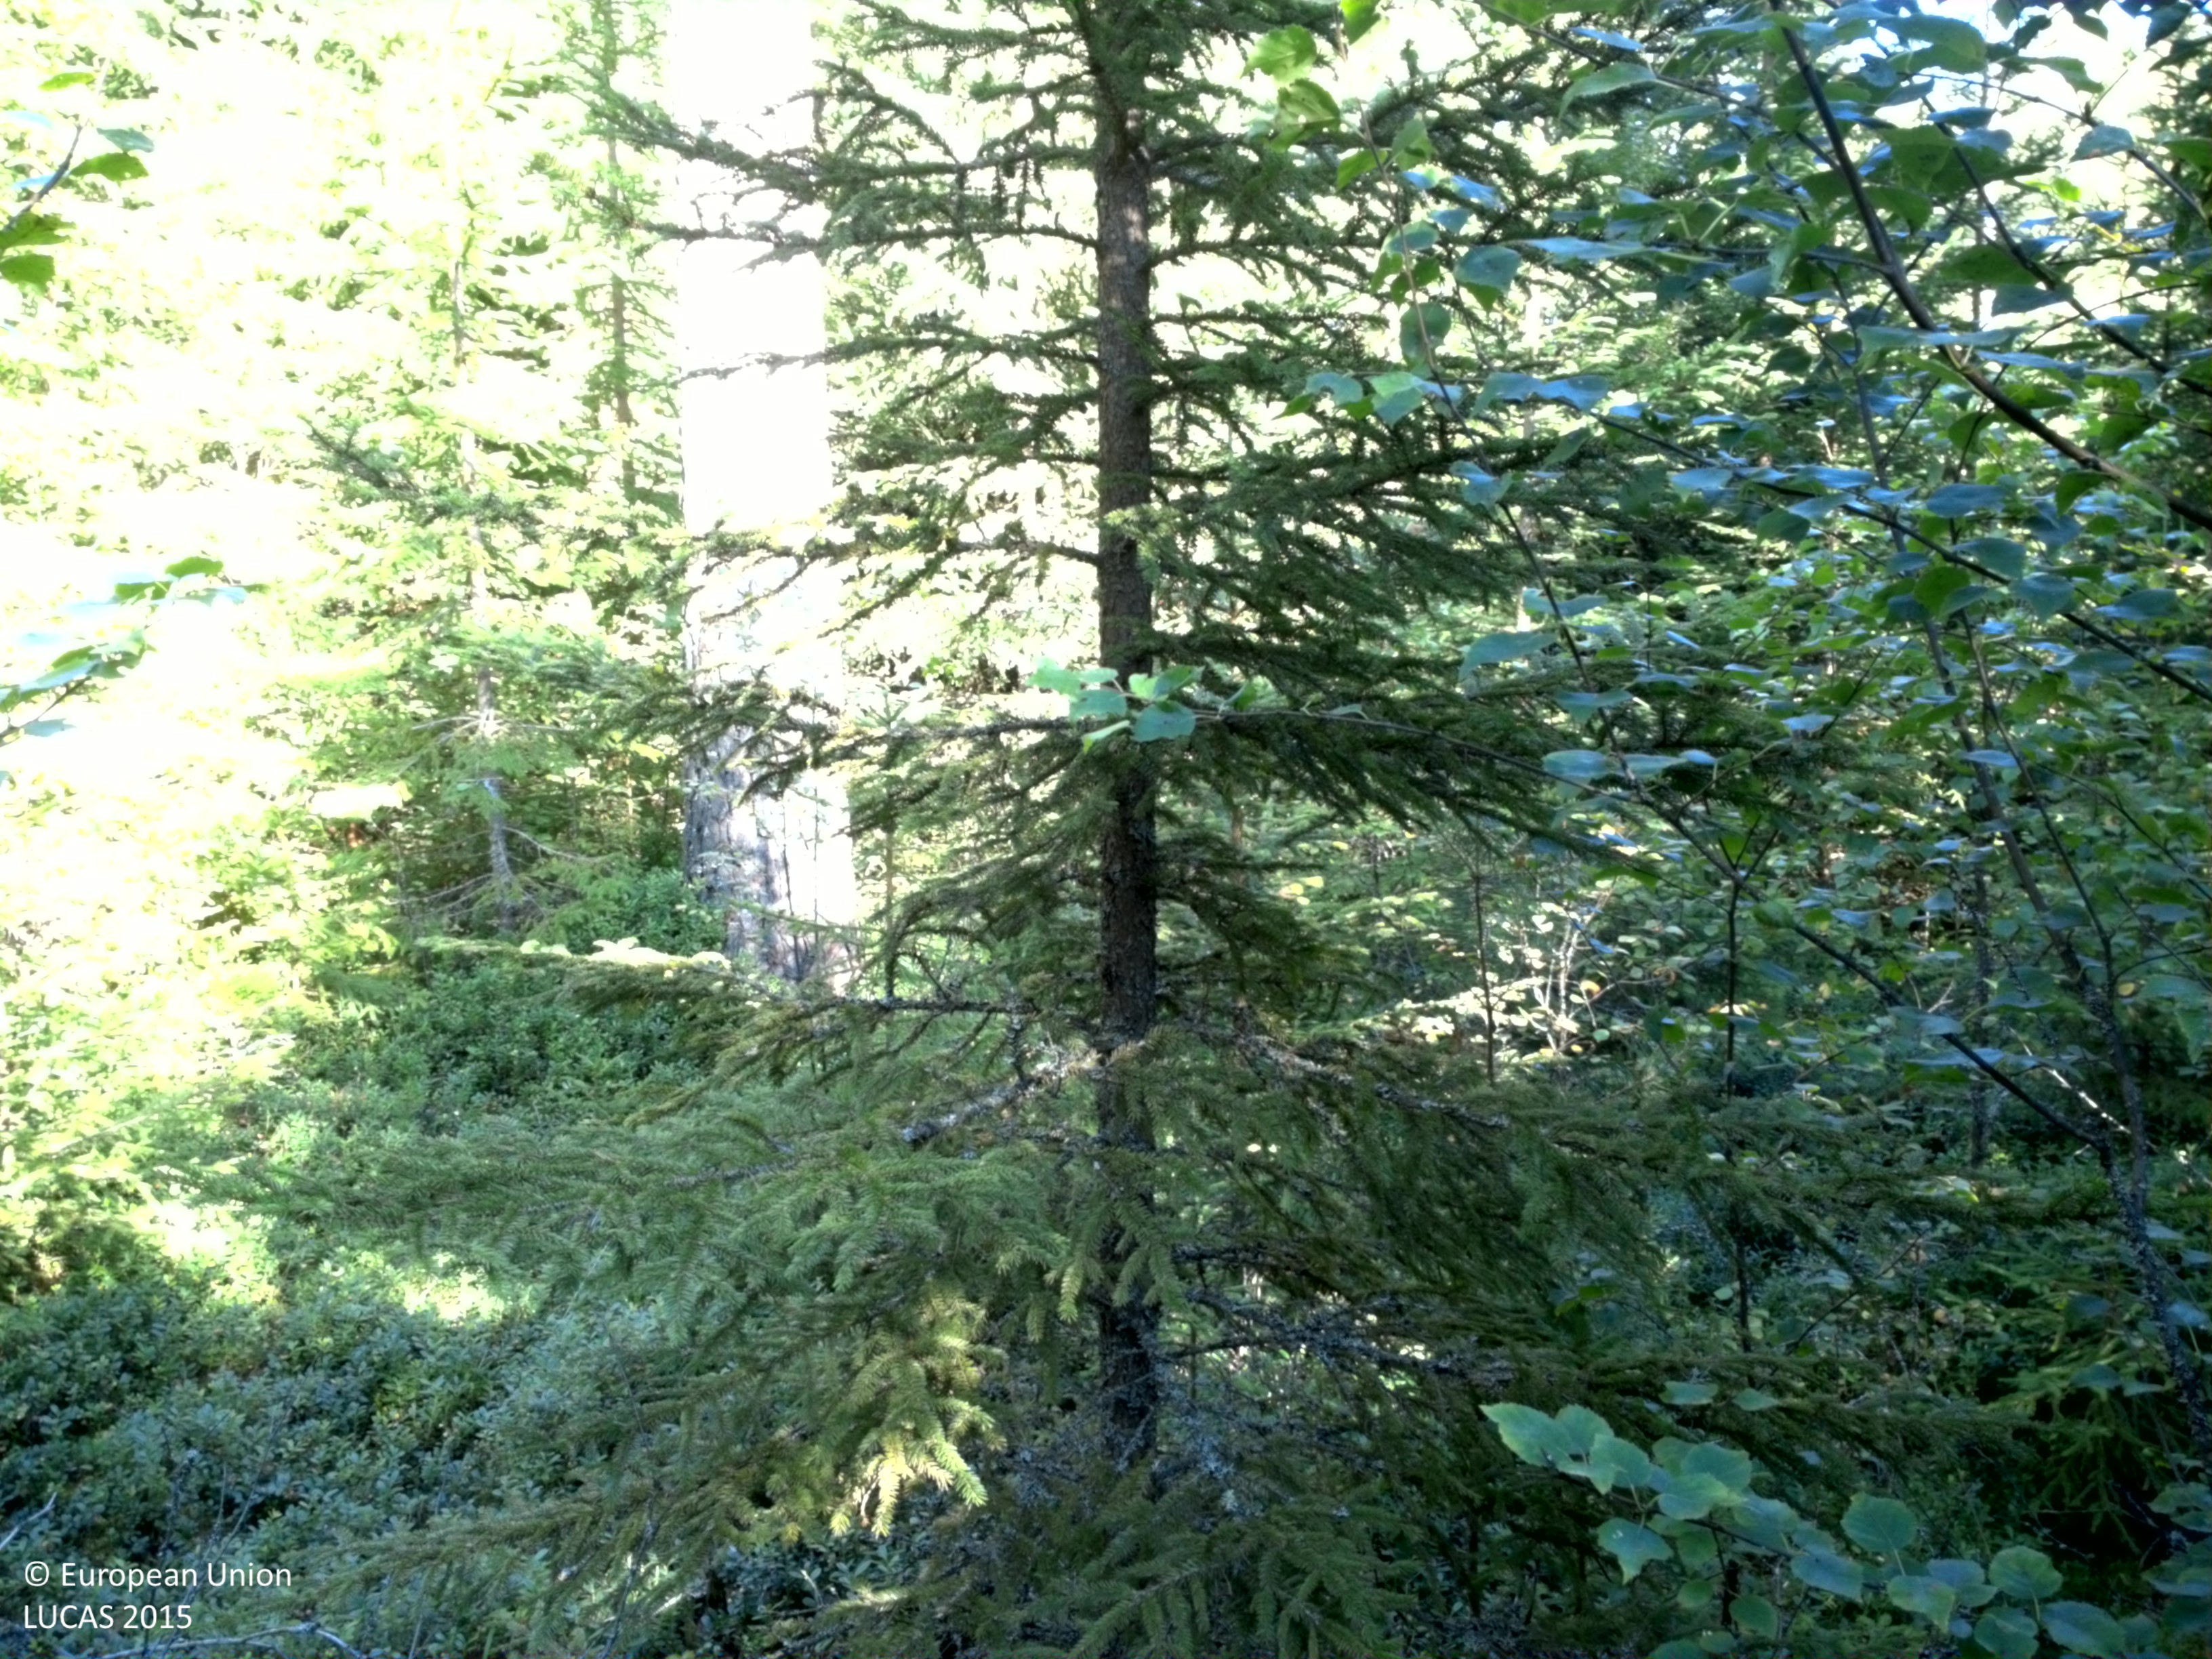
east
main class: Woodland
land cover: Spruce dominated mixed woodland
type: boreal forest
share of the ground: > 75 %
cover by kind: coniferous forest trees 50 %, broadleaved forest trees 35 %, shrubs 15 %
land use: Forestry
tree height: > 5 m
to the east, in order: Spruce dominated mixed woodland; Spruce dominated coniferous woodland; Spruce dominated mixed woodland; Tracks; Spruce dominated mixed woodland
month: August
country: SE
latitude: 59.7774
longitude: 14.1404
